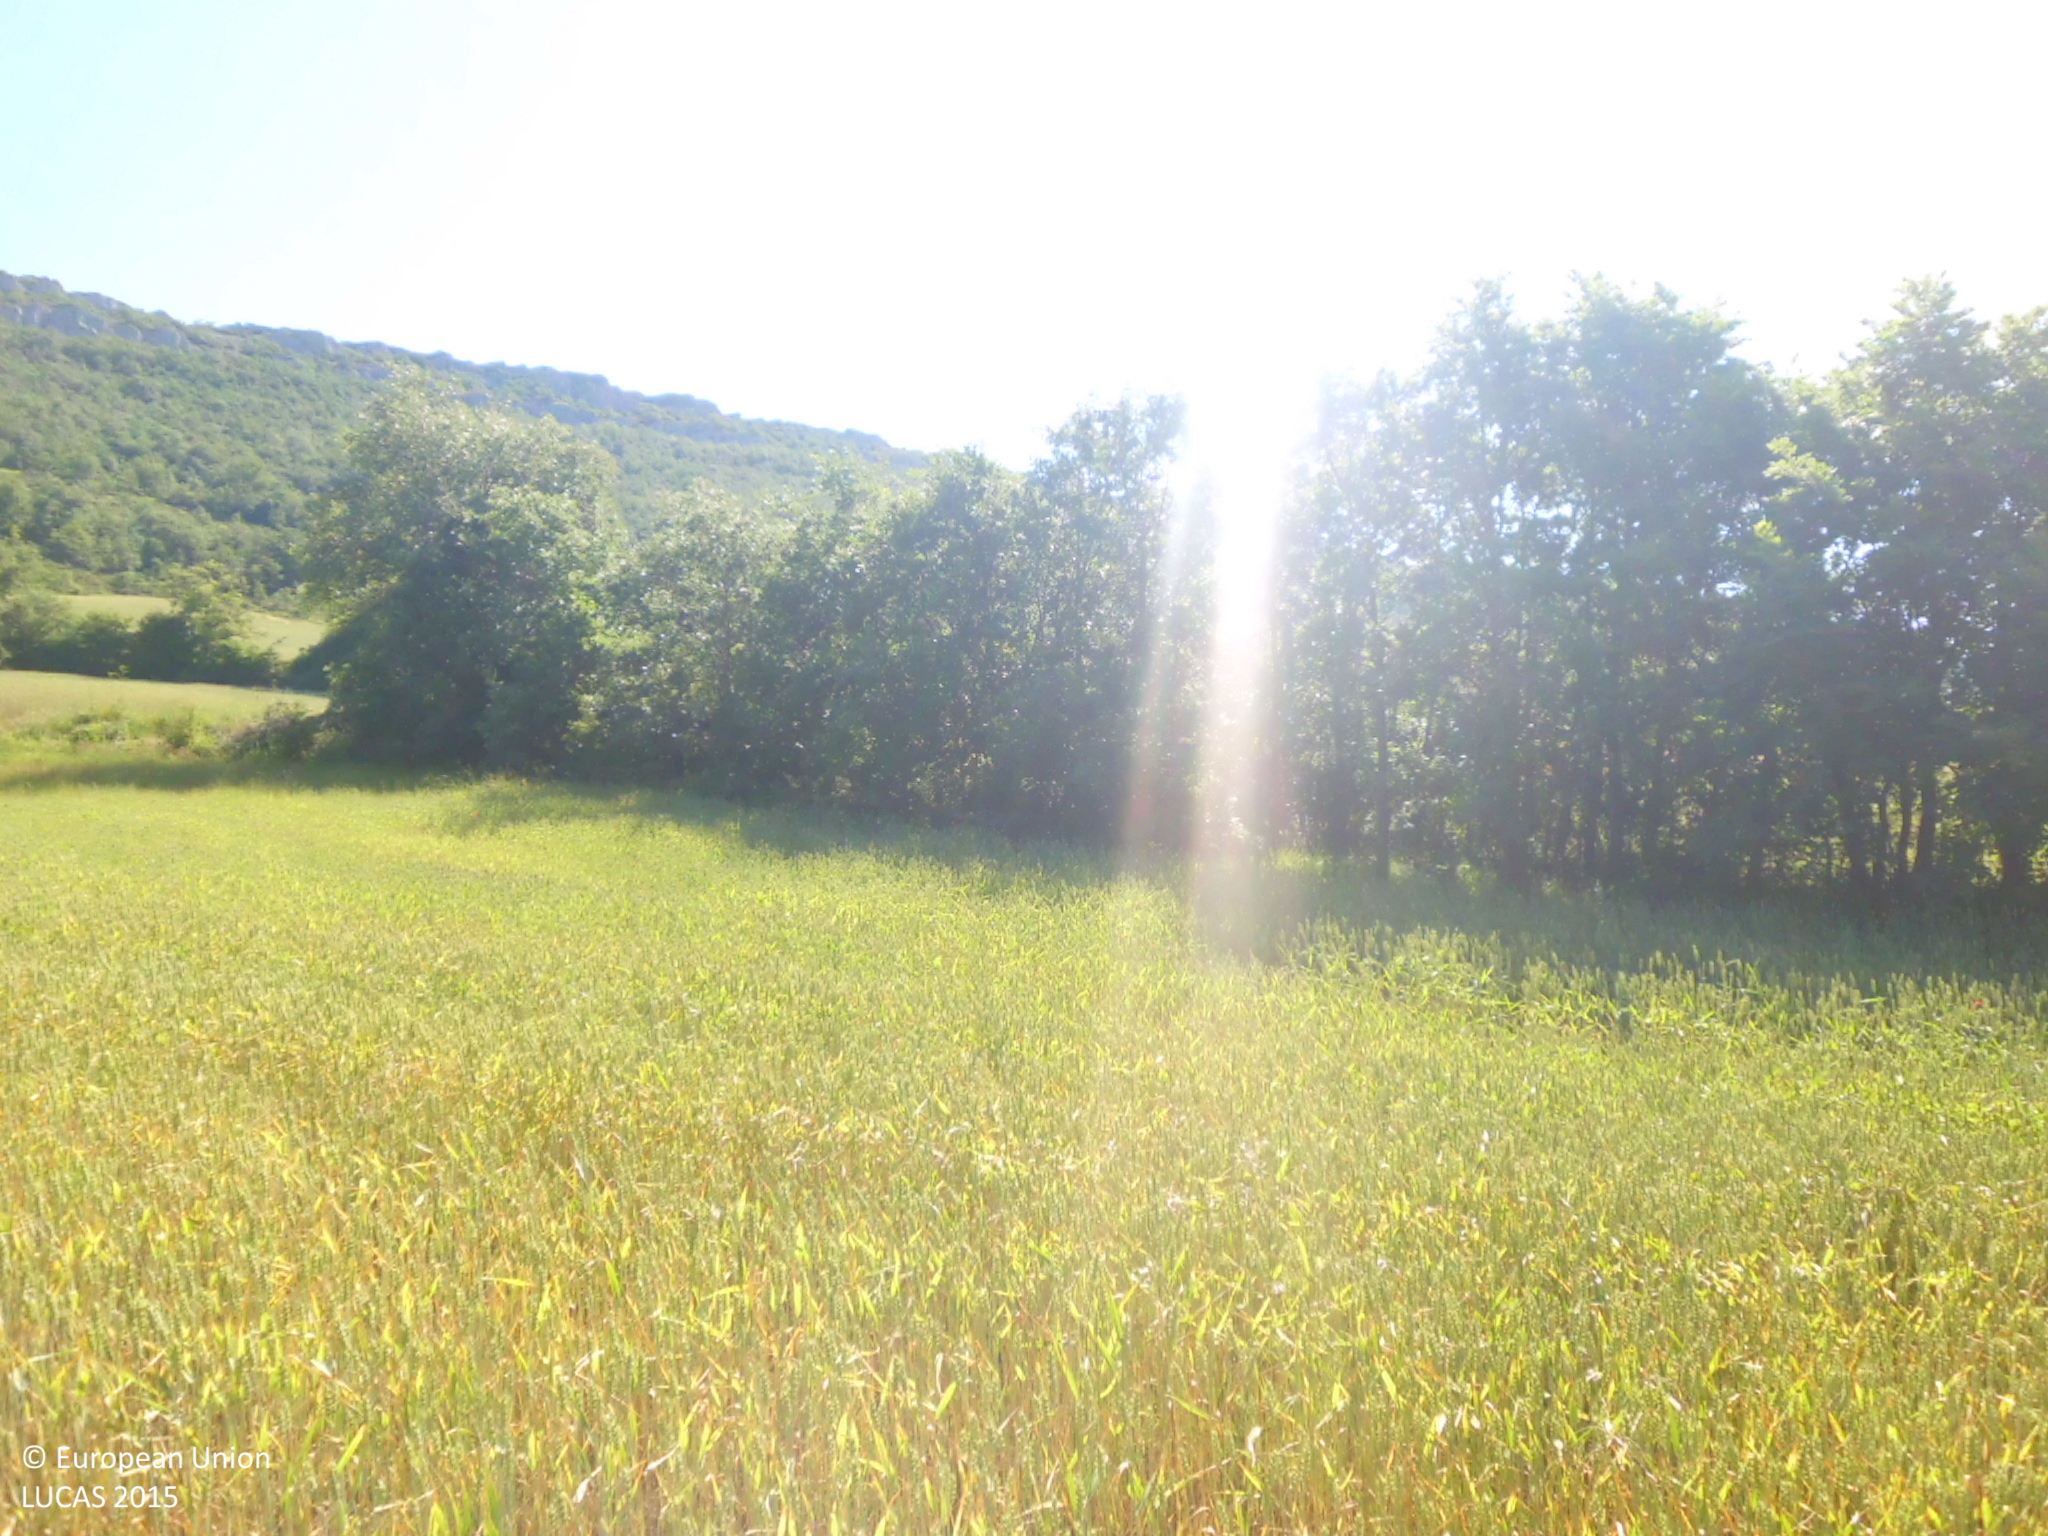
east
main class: Woodland
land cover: Broadleaved woodland
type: acidophilous oak and oak-birch forest
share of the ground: 50 - 75 %
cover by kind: broadleaved forest trees 50 %, herbaceous plants 50 %
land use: Forestry
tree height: > 5 m
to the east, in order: Common wheat; Grass margins; Common wheat; Abandoned hedges; Grassland with sparse tree/shrub cover; Abandoned hedges; Common wheat; Broadleaved woodland
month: June
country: ES
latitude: 42.6735
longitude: -4.0660
